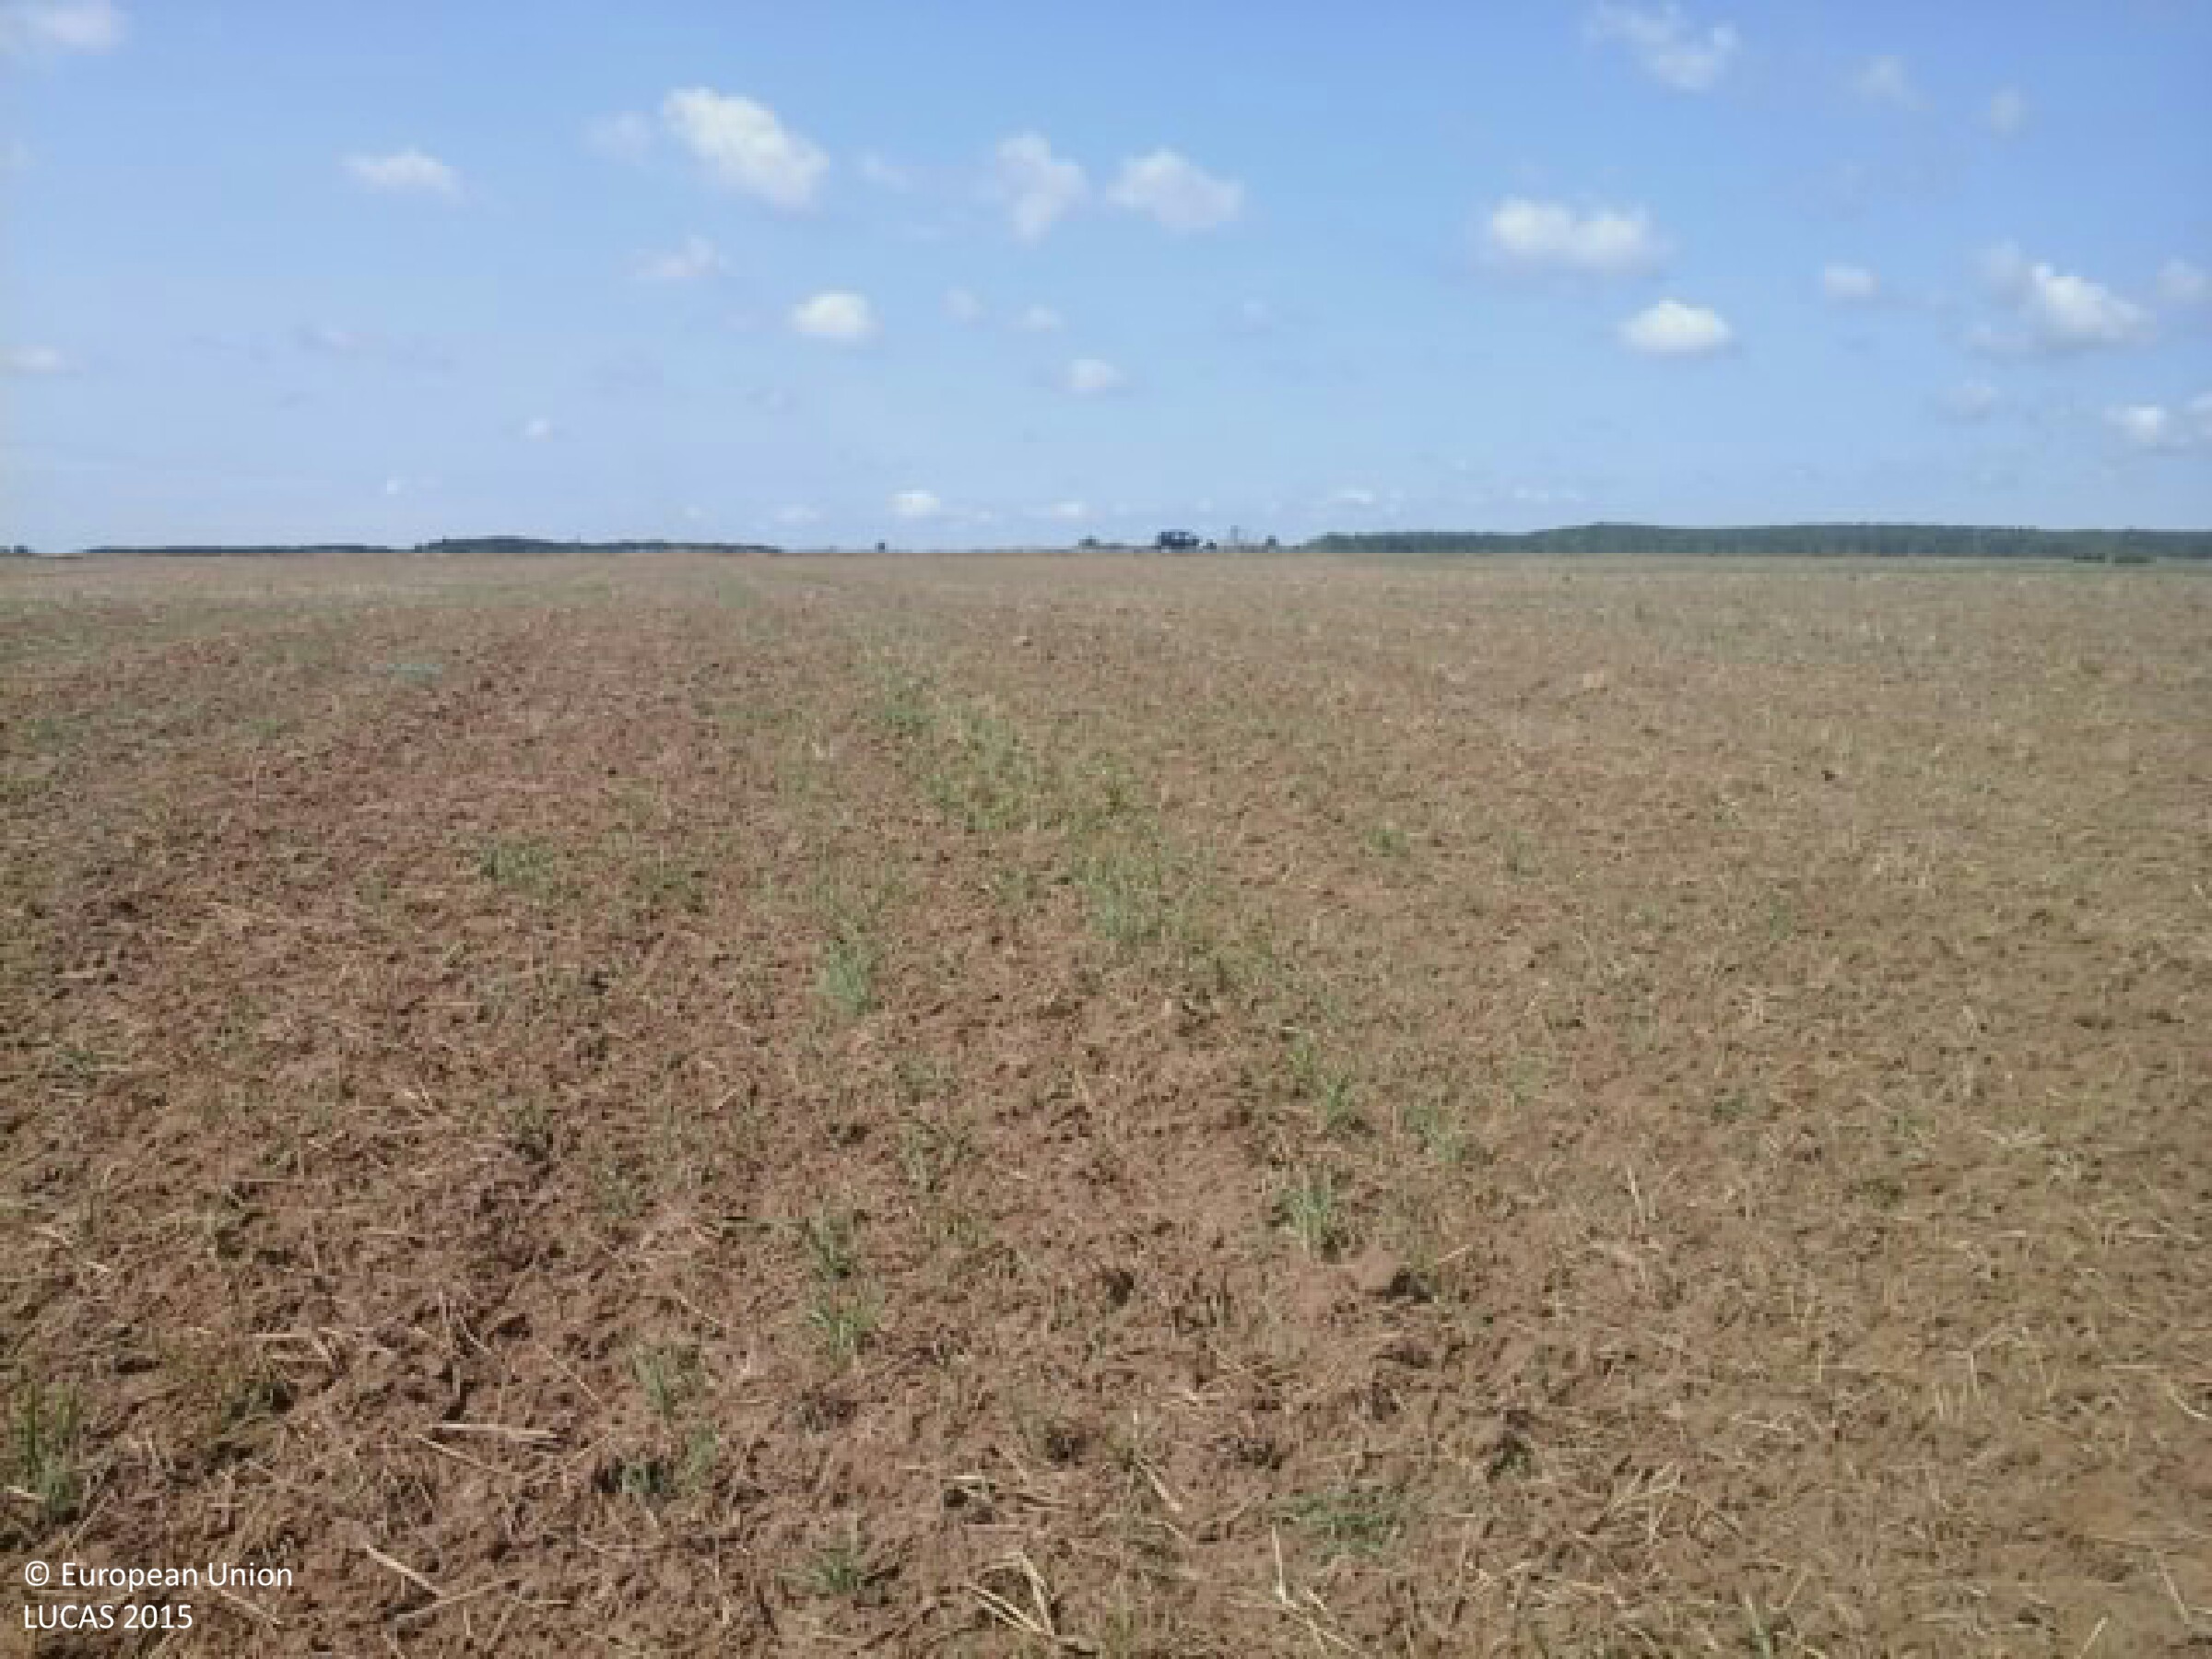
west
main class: Cropland
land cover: Common wheat
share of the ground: < 10 %
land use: Agriculture (excluding fallow land and kitchen gardens)
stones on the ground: < 10 %
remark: Harvested field
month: August
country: HU
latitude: 46.1866
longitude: 17.6356
